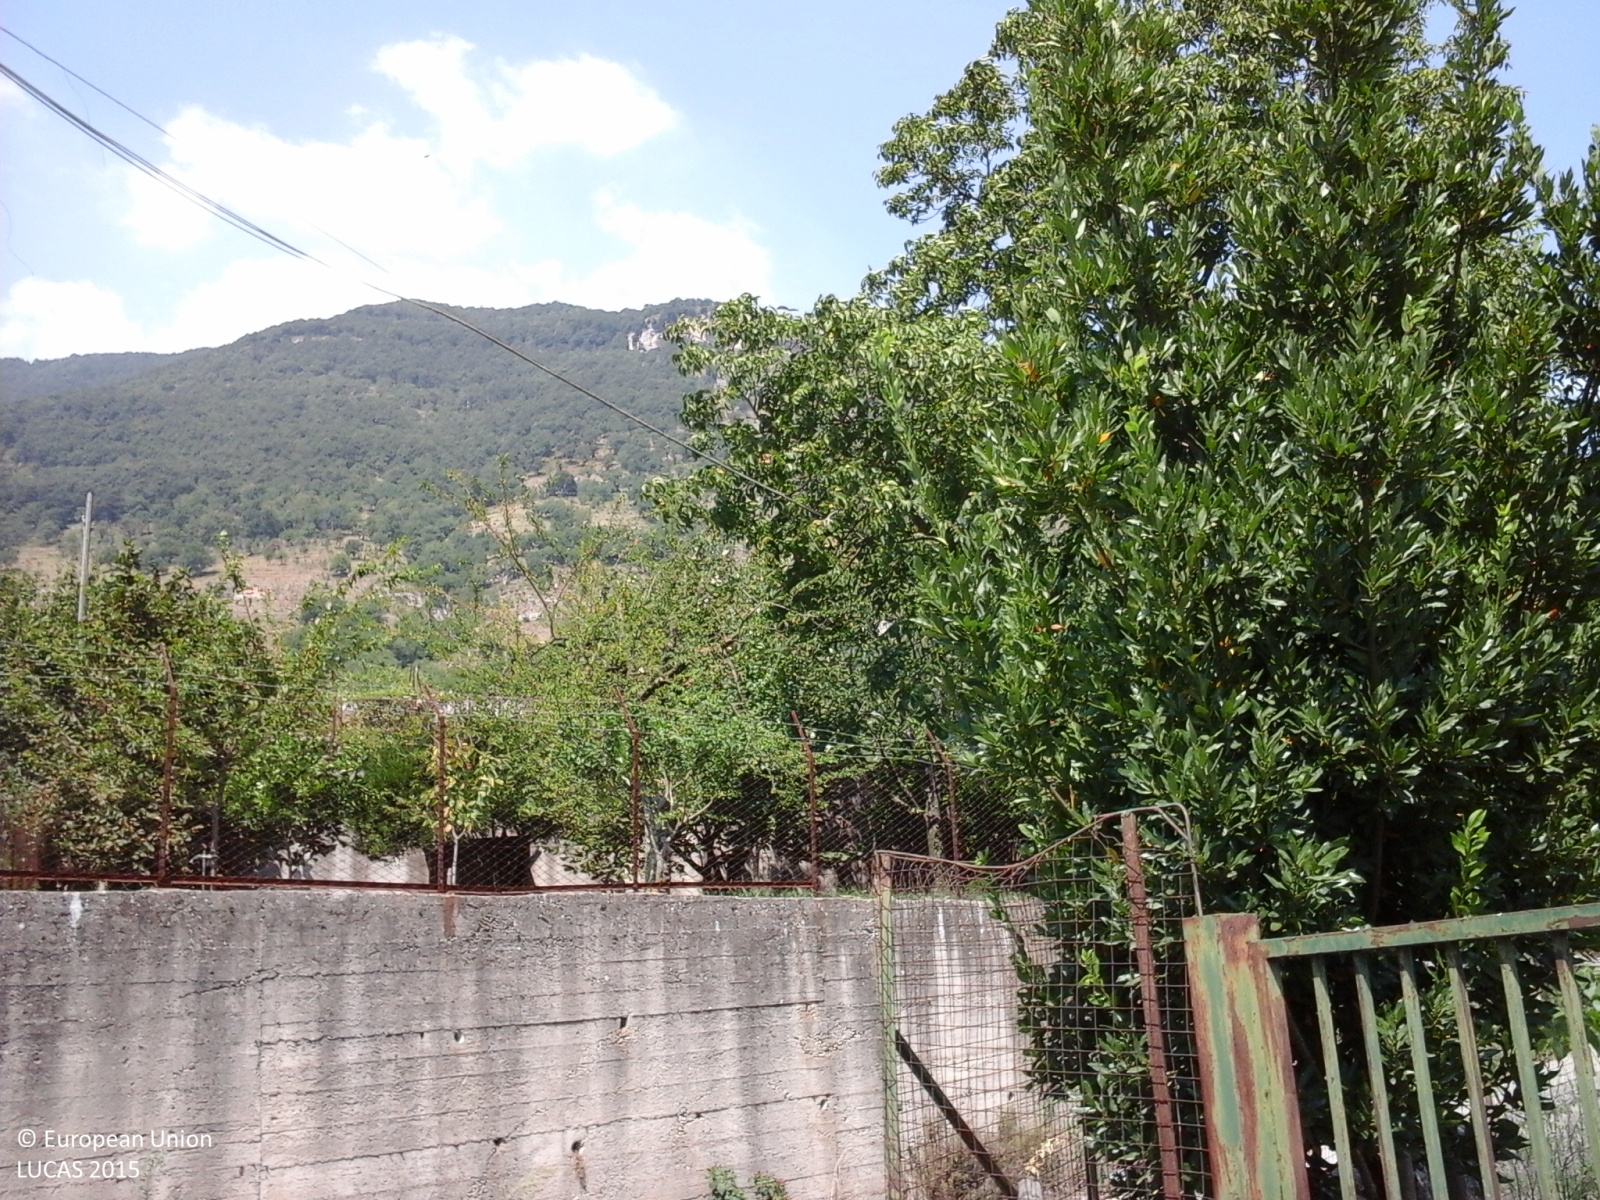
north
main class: Cropland
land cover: Vineyards
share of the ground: 25 - 50 %
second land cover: Tomatoes
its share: < 10 %
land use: Agriculture (excluding fallow land and kitchen gardens)
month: August
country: IT
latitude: 40.8077
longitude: 14.6869
